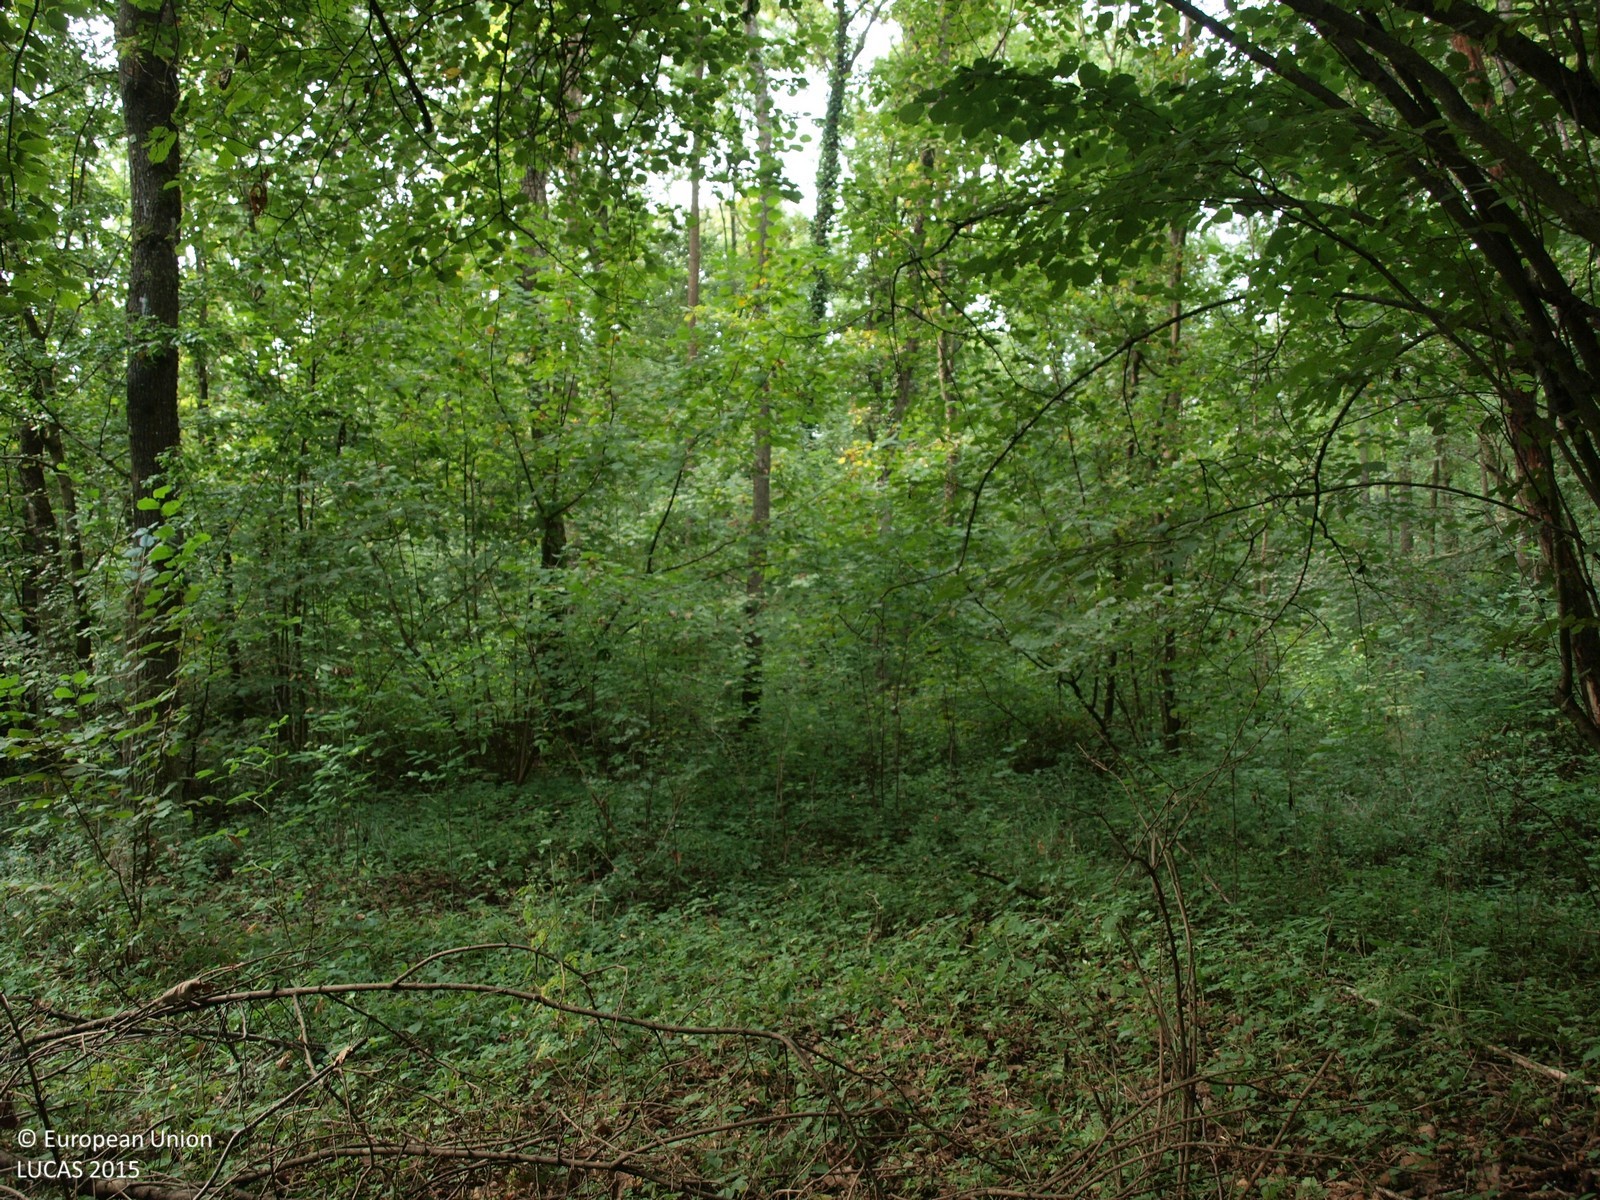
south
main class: Woodland
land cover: Broadleaved woodland
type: floodplain forest
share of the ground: > 75 %
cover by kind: broadleaved forest trees 100 %
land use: Forestry
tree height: > 5 m
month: September
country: HR
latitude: 45.7419
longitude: 16.1288
